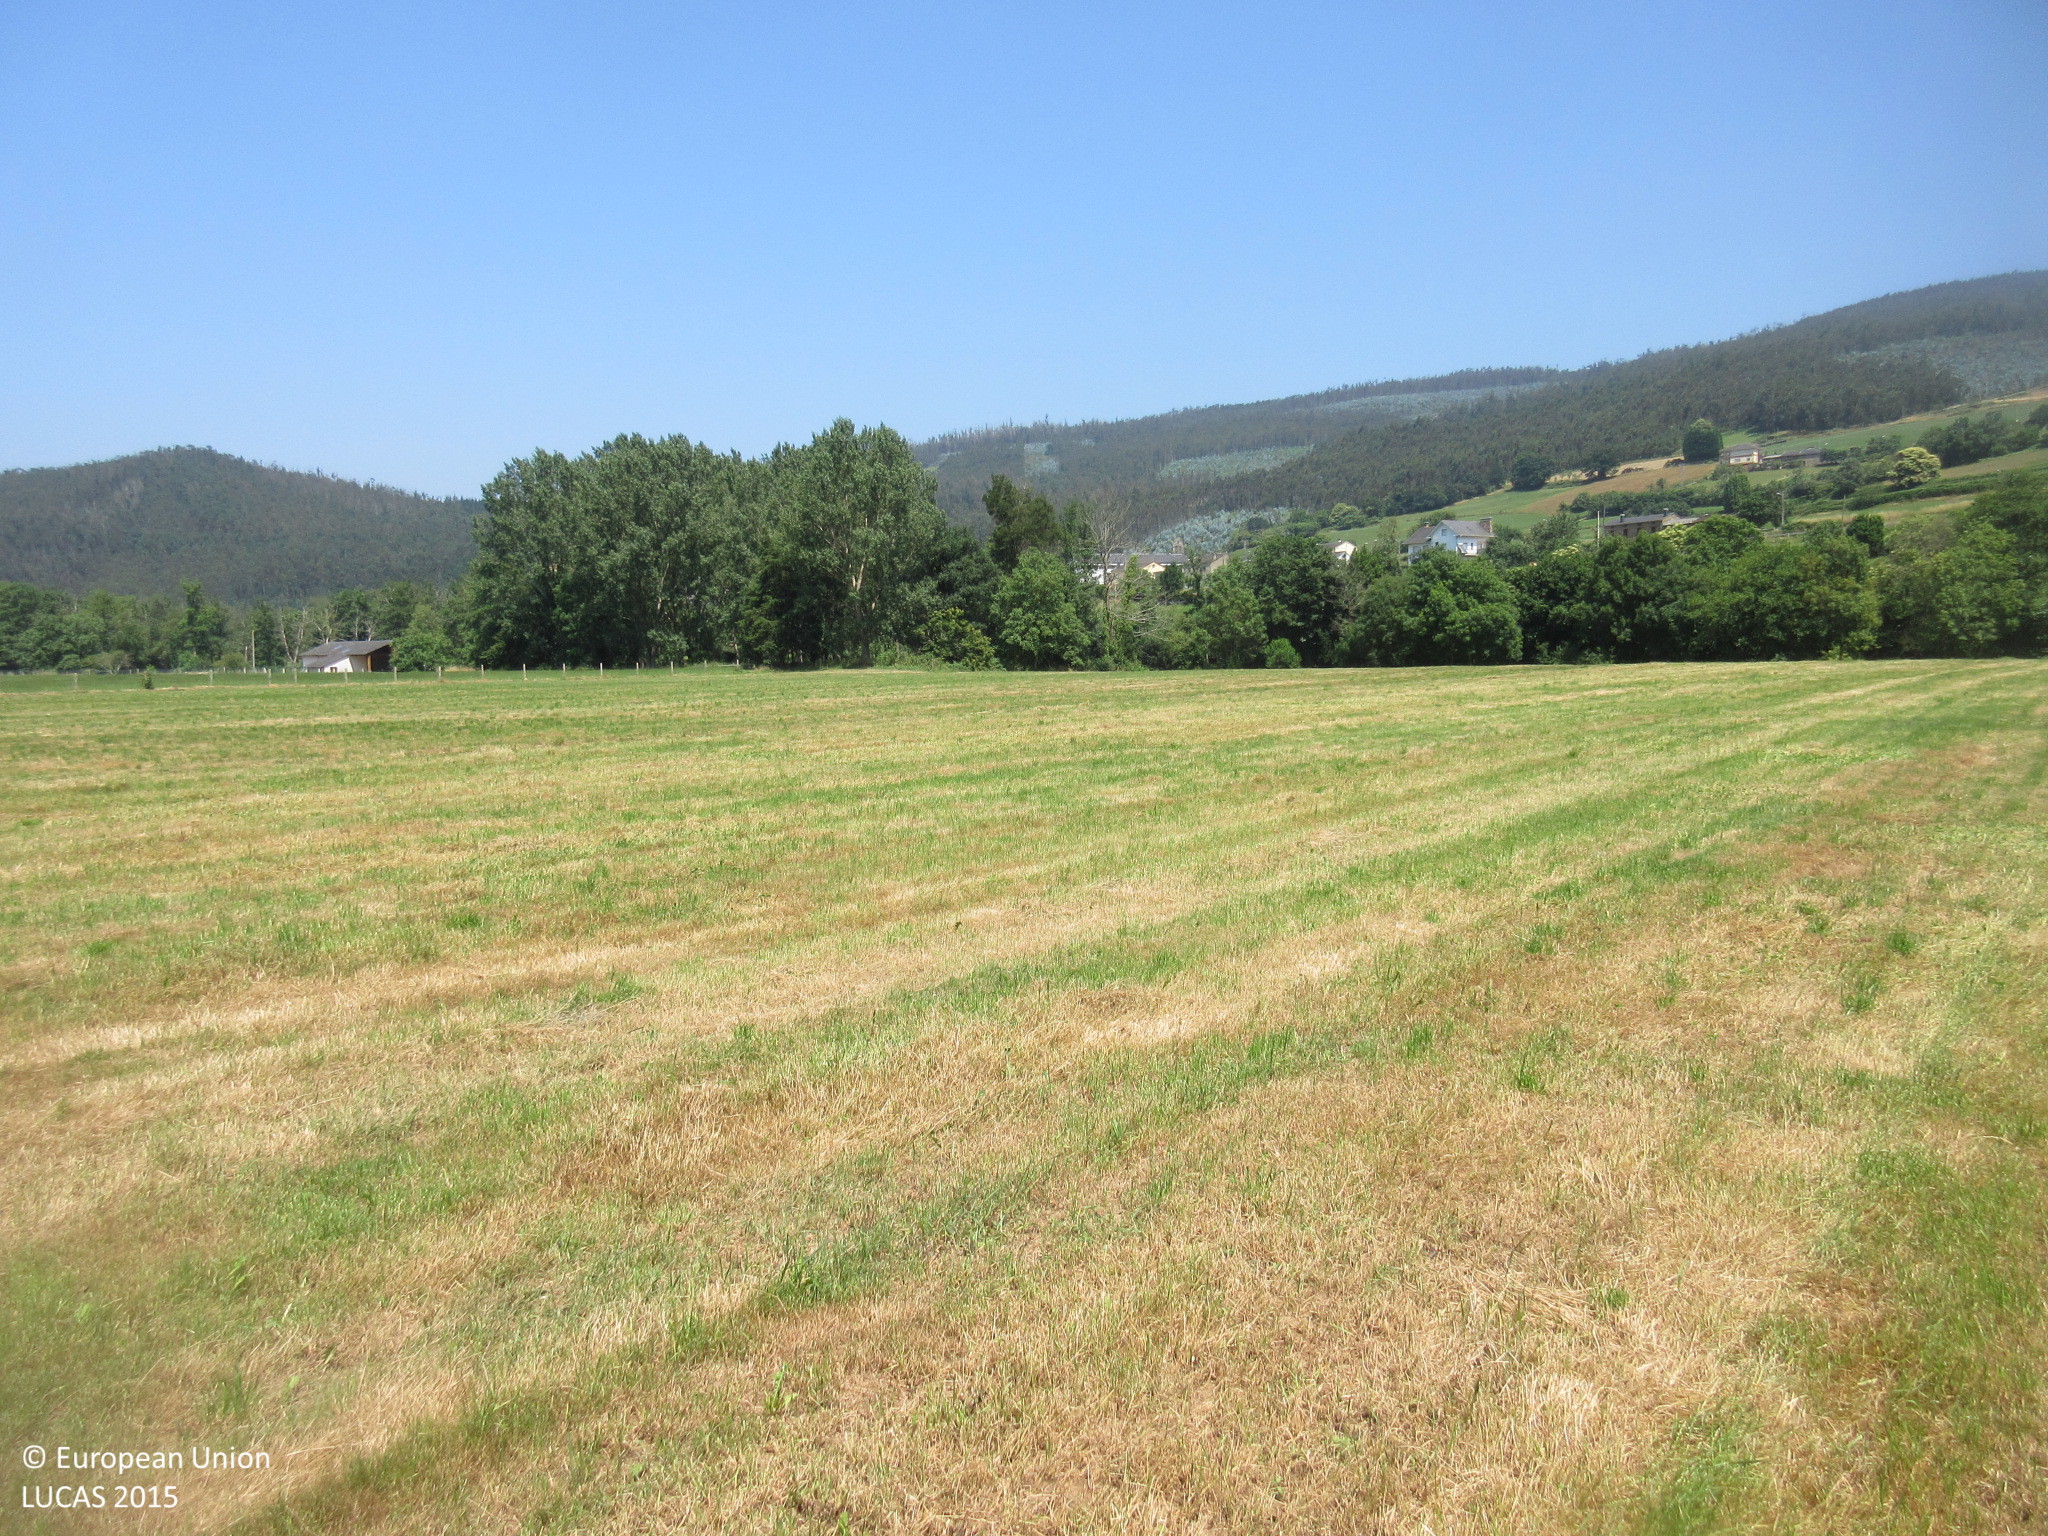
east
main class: Grassland
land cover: Grassland without tree/shrub cover
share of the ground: > 75 %
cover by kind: herbaceous plants 100 %
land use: Agriculture (excluding fallow land and kitchen gardens)
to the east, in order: Grassland without tree/shrub cover; Abandoned hedges; Inland fresh running water; Broadleaved woodland; Maize
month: June
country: ES
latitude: 43.4069
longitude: -7.1488
